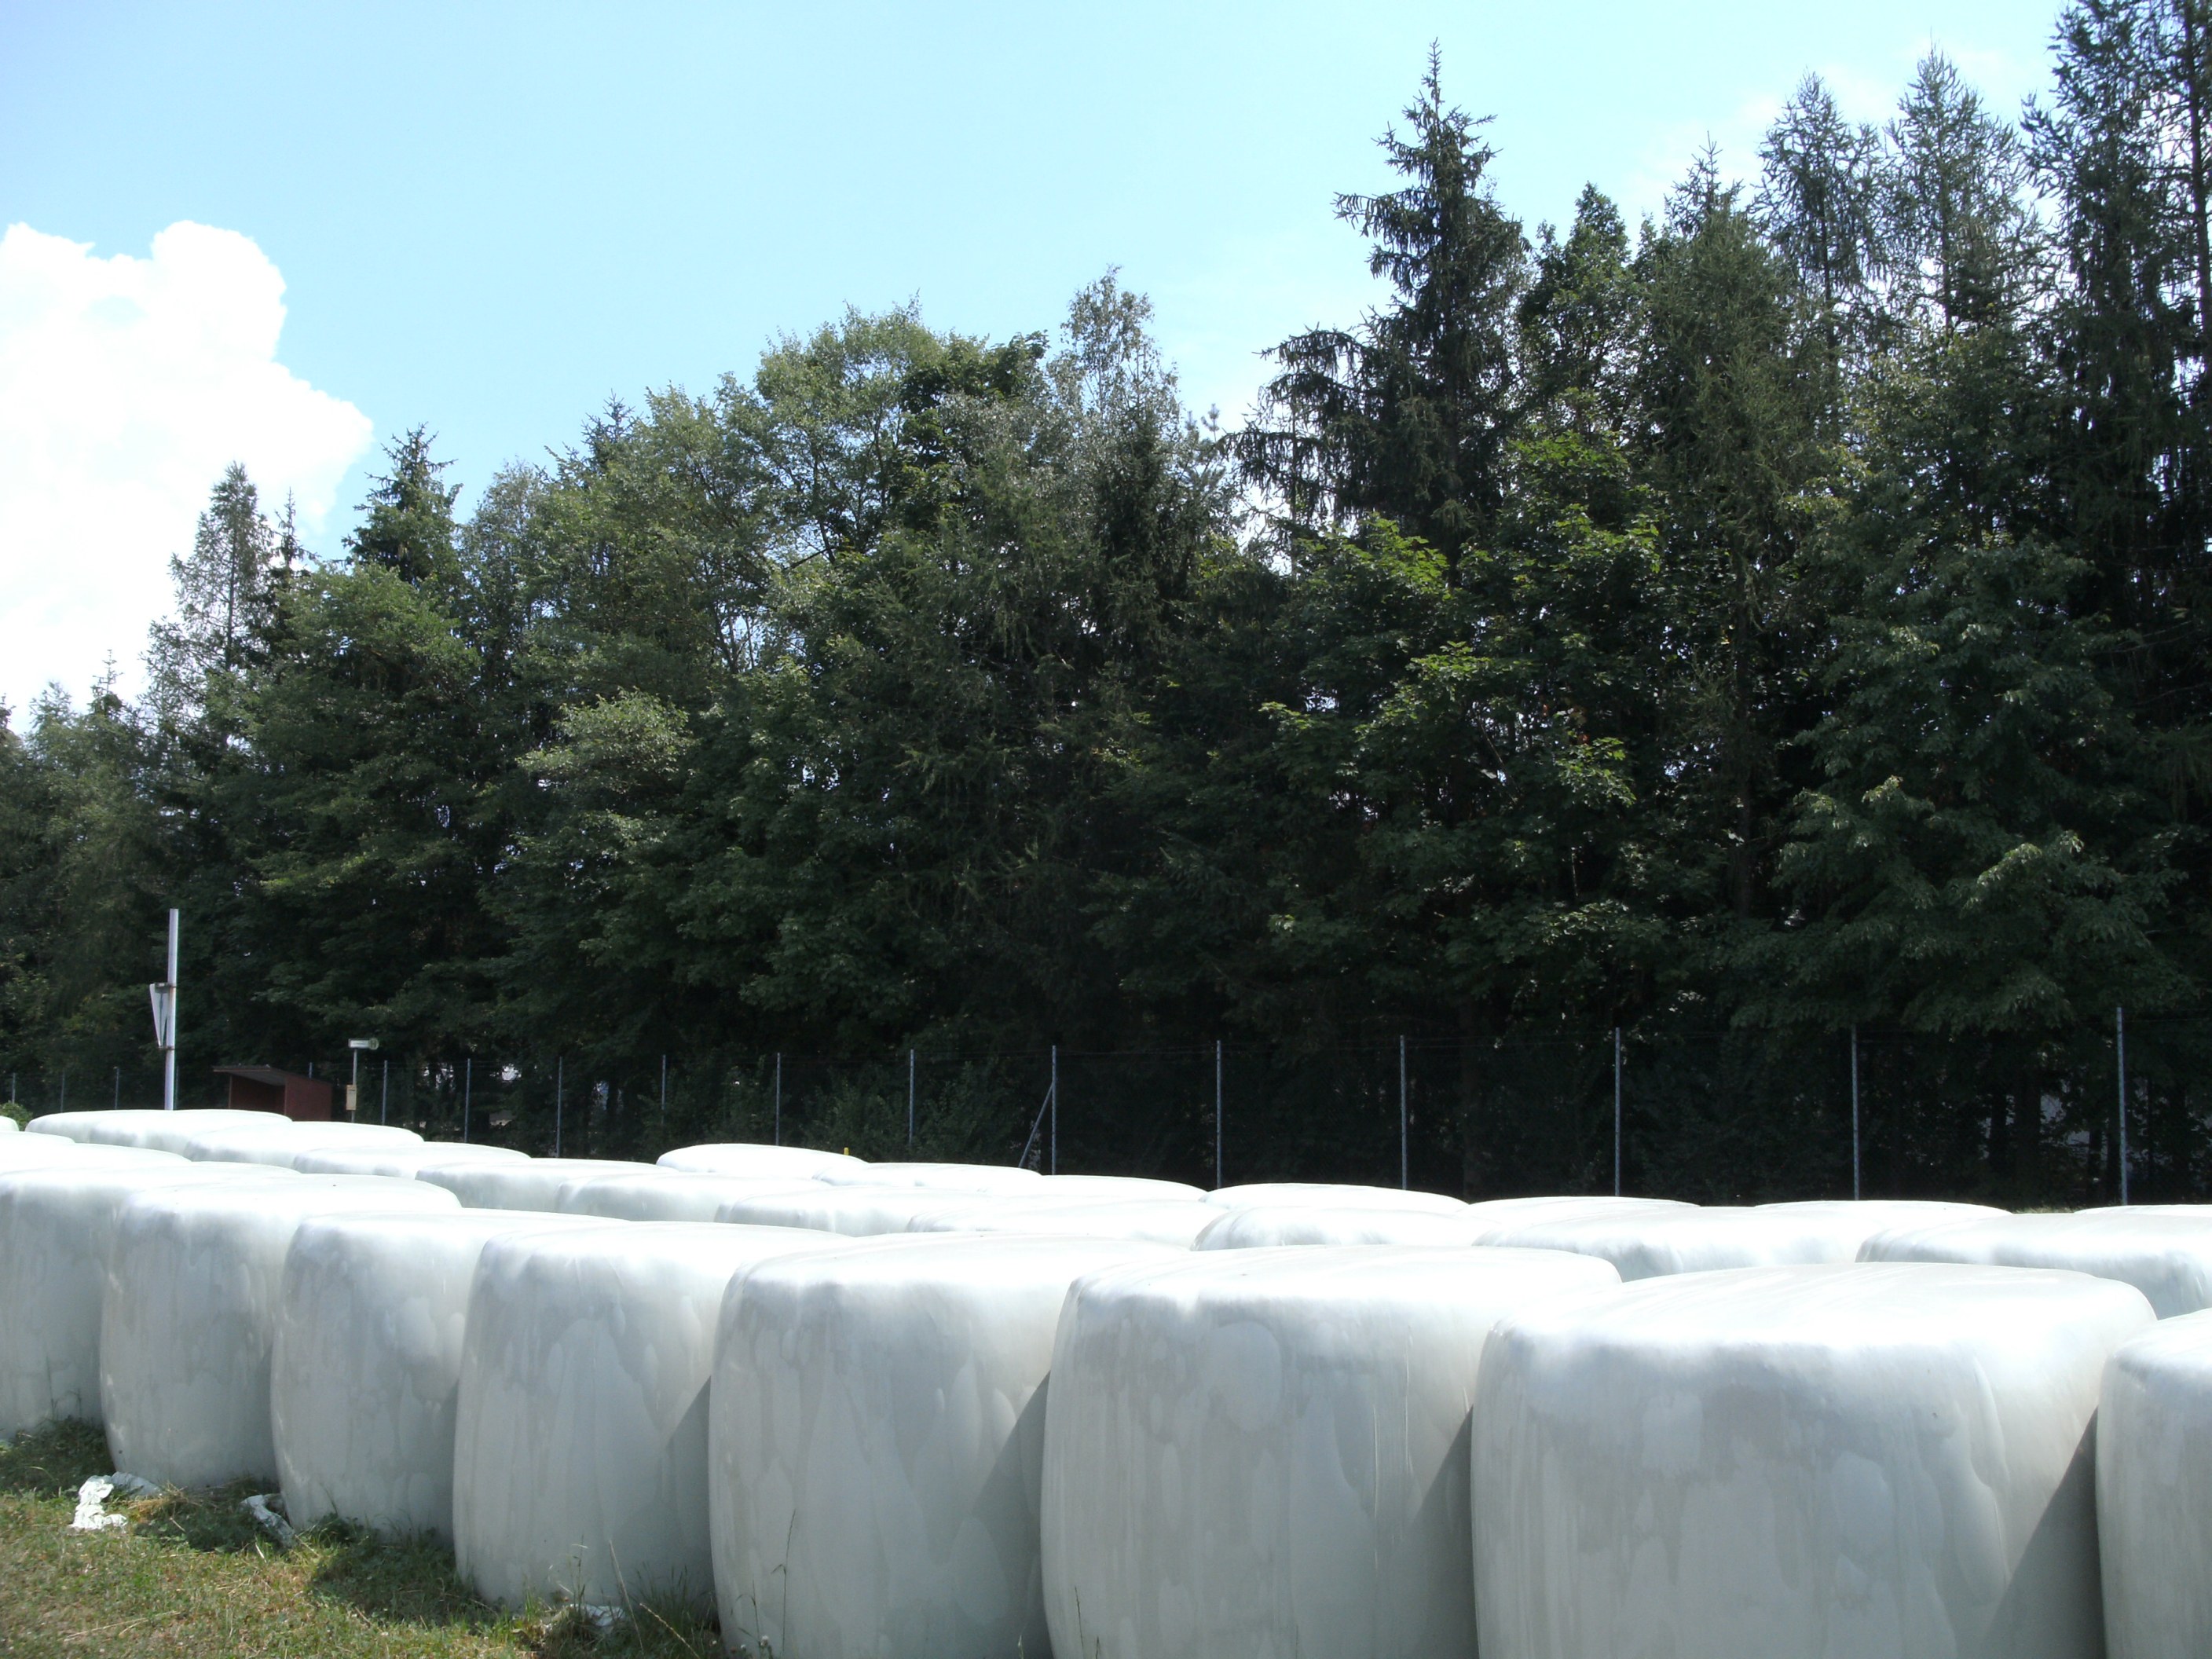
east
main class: Grassland
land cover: Grassland without tree/shrub cover
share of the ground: > 75 %
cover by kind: herbaceous plants 80 %, unconsolidated bare surface 20 %
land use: Agriculture (excluding fallow land and kitchen gardens)
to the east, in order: Grassland without tree/shrub cover; Artificial constructions; Grass margins; Artificial constructions in urban areas; Grassland without tree/shrub cover; Shrubland with sparse tree cover; Electric lines
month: July
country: AT
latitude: 46.6575
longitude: 14.8201
